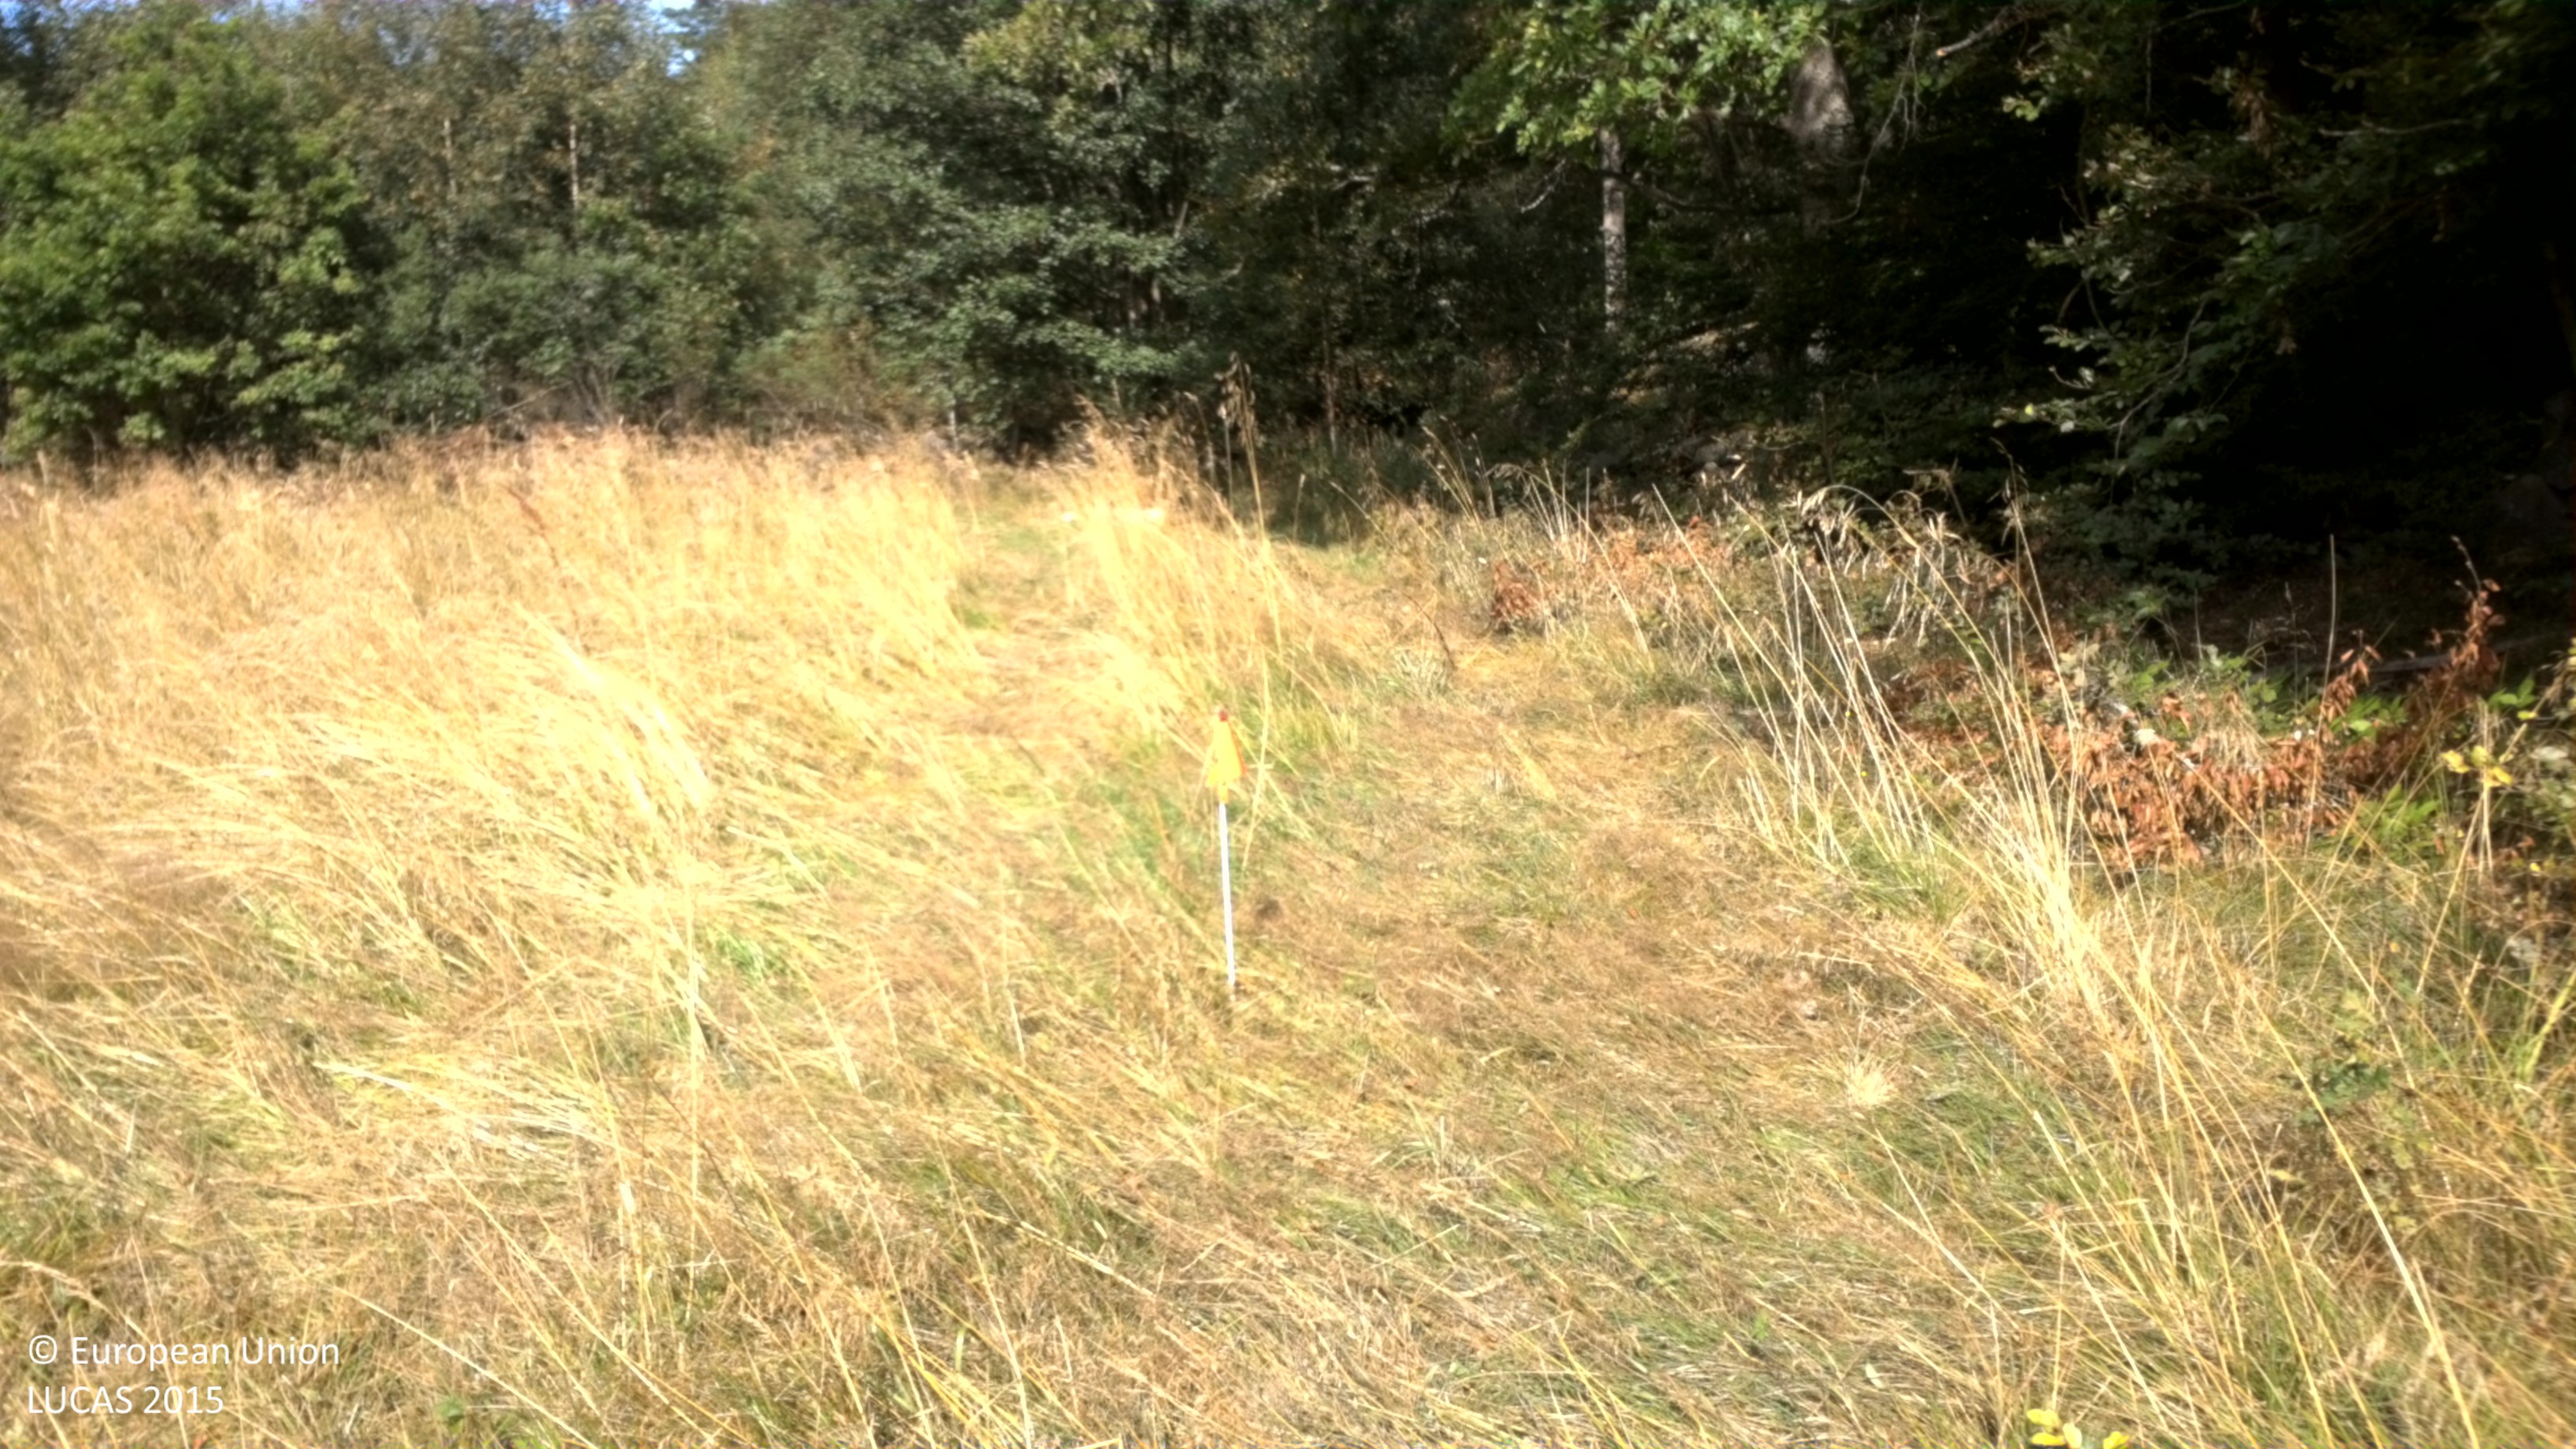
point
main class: Grassland
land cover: Grassland without tree/shrub cover
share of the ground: > 75 %
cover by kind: herbaceous plants 100 %
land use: Agriculture (excluding fallow land and kitchen gardens)
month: August
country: SE
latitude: 56.1887
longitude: 14.7841
